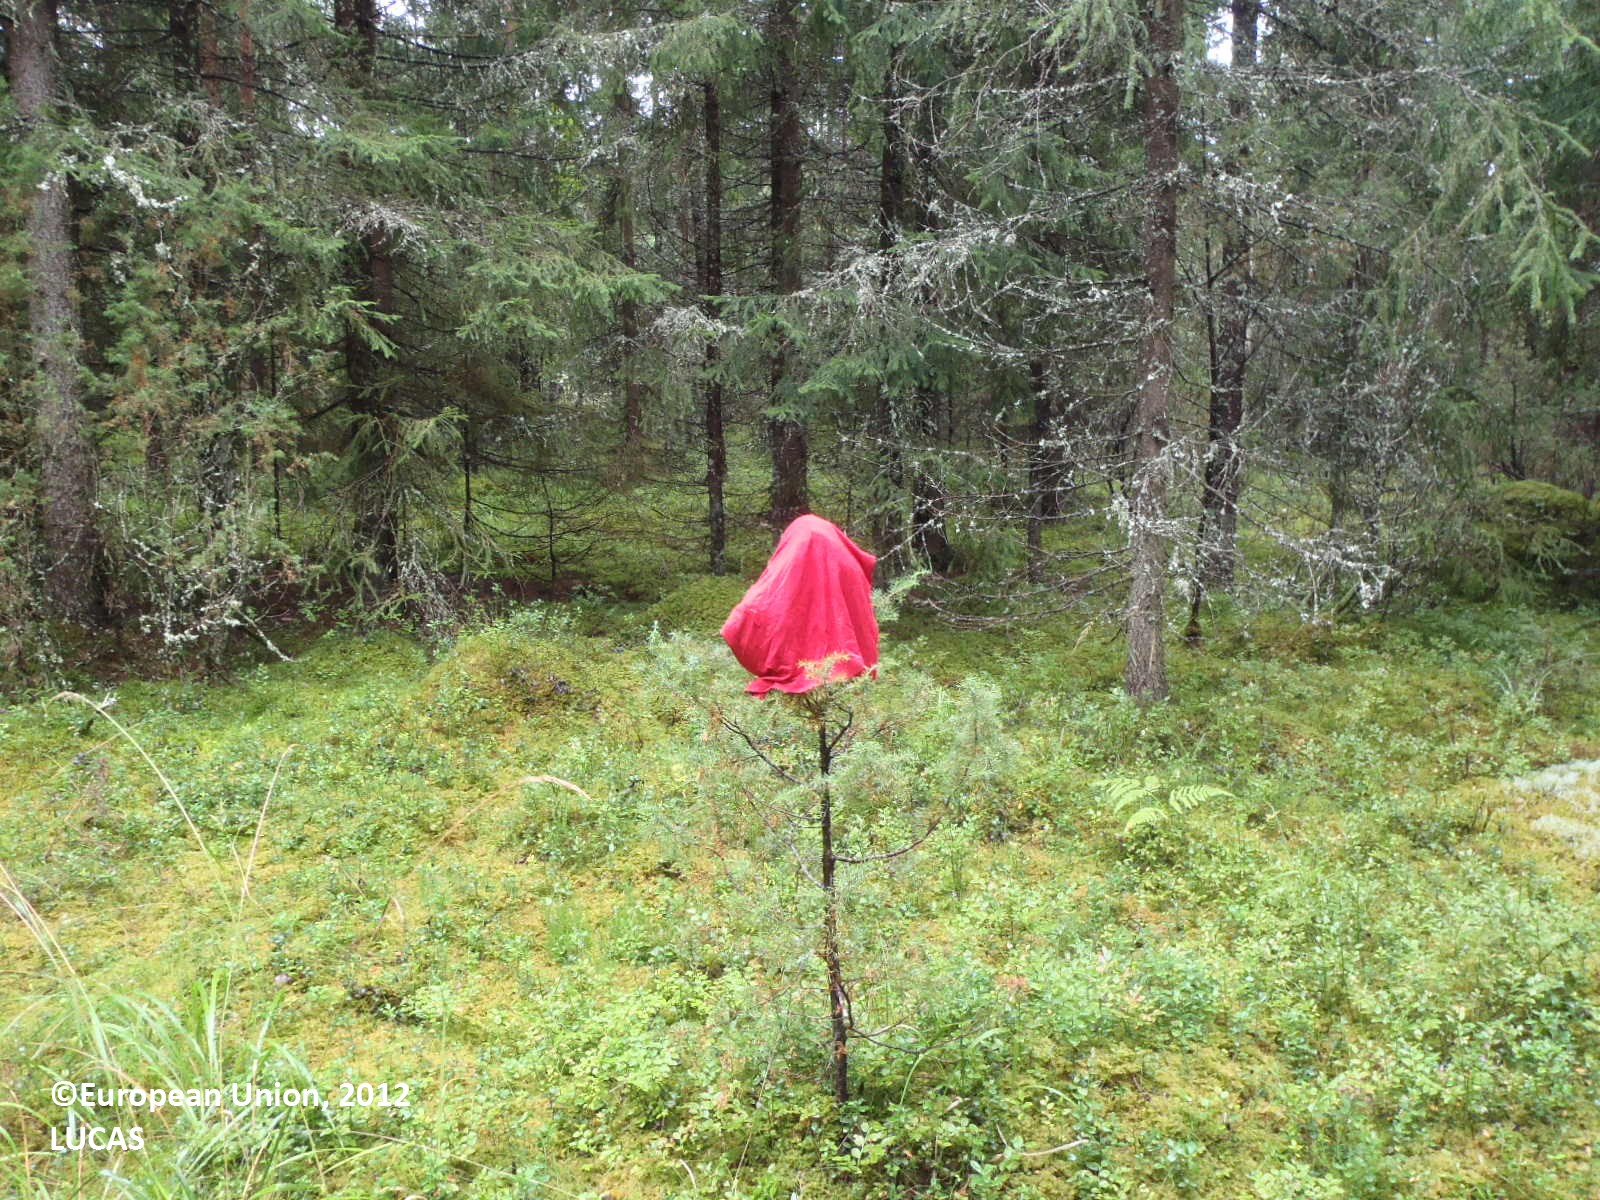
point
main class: Woodland
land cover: Spruce dominated coniferous woodland
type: boreal forest
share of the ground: > 75 %
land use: Forestry
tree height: > 5 m
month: August
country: FI
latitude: 60.7271
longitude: 22.1828
